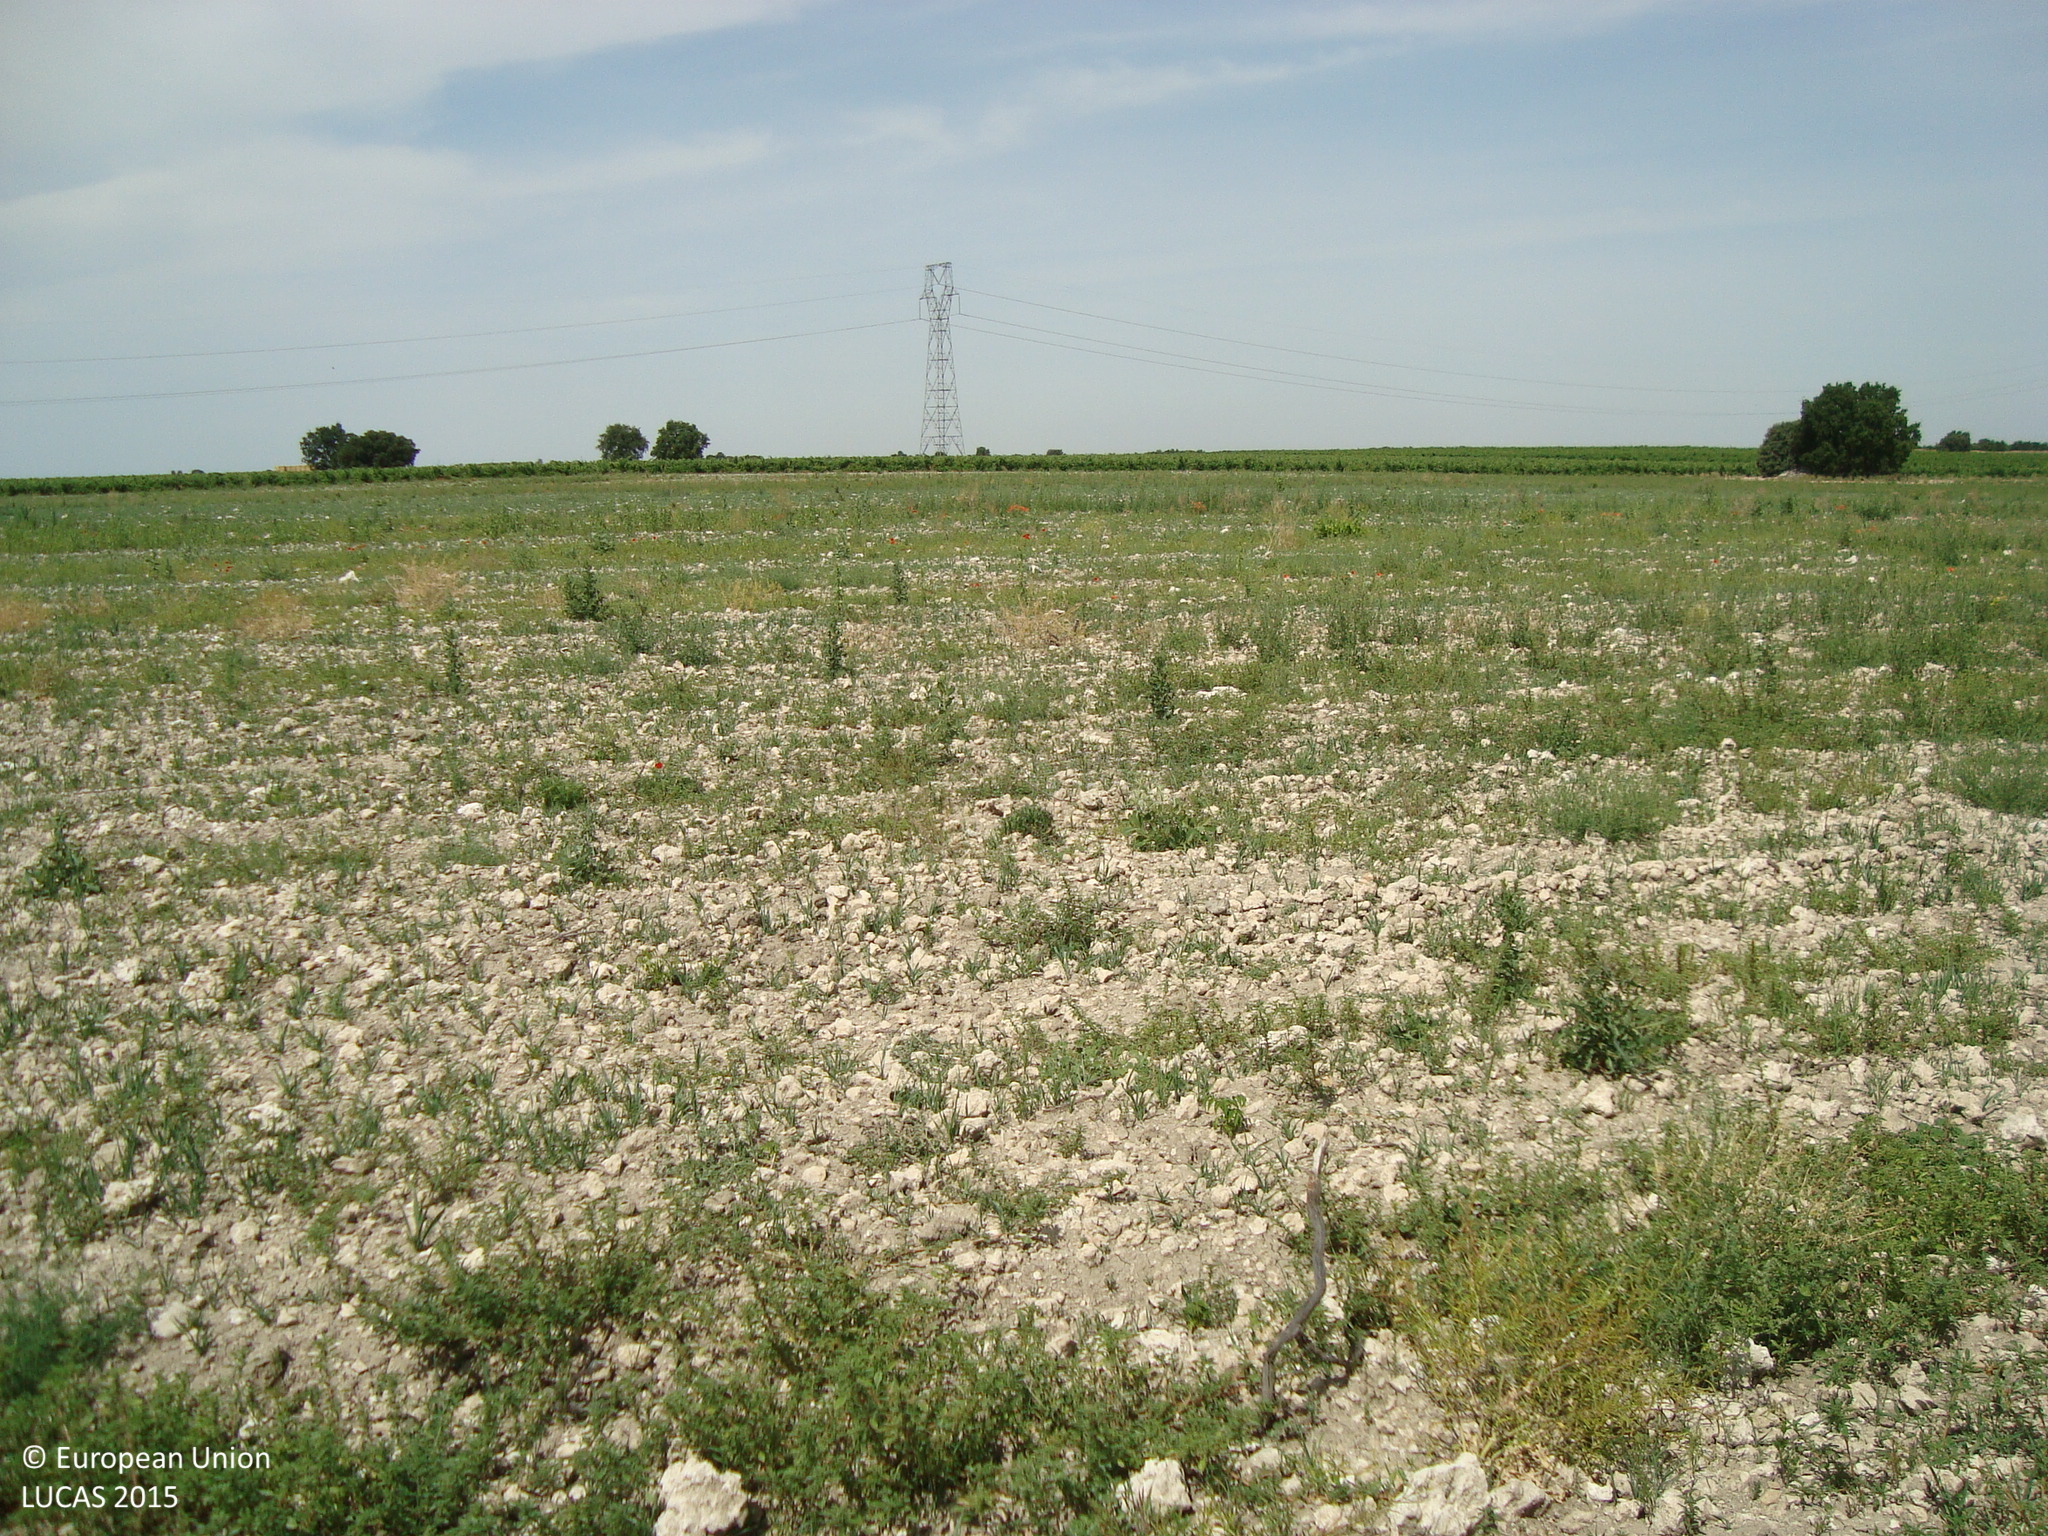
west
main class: Grassland
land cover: Spontaneously vegetated surfaces
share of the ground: 25 - 50 %
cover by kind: unconsolidated bare surface 60 %, herbaceous plants 40 %
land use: Abandoned areas
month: July
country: ES
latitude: 41.7265
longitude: -4.1618
